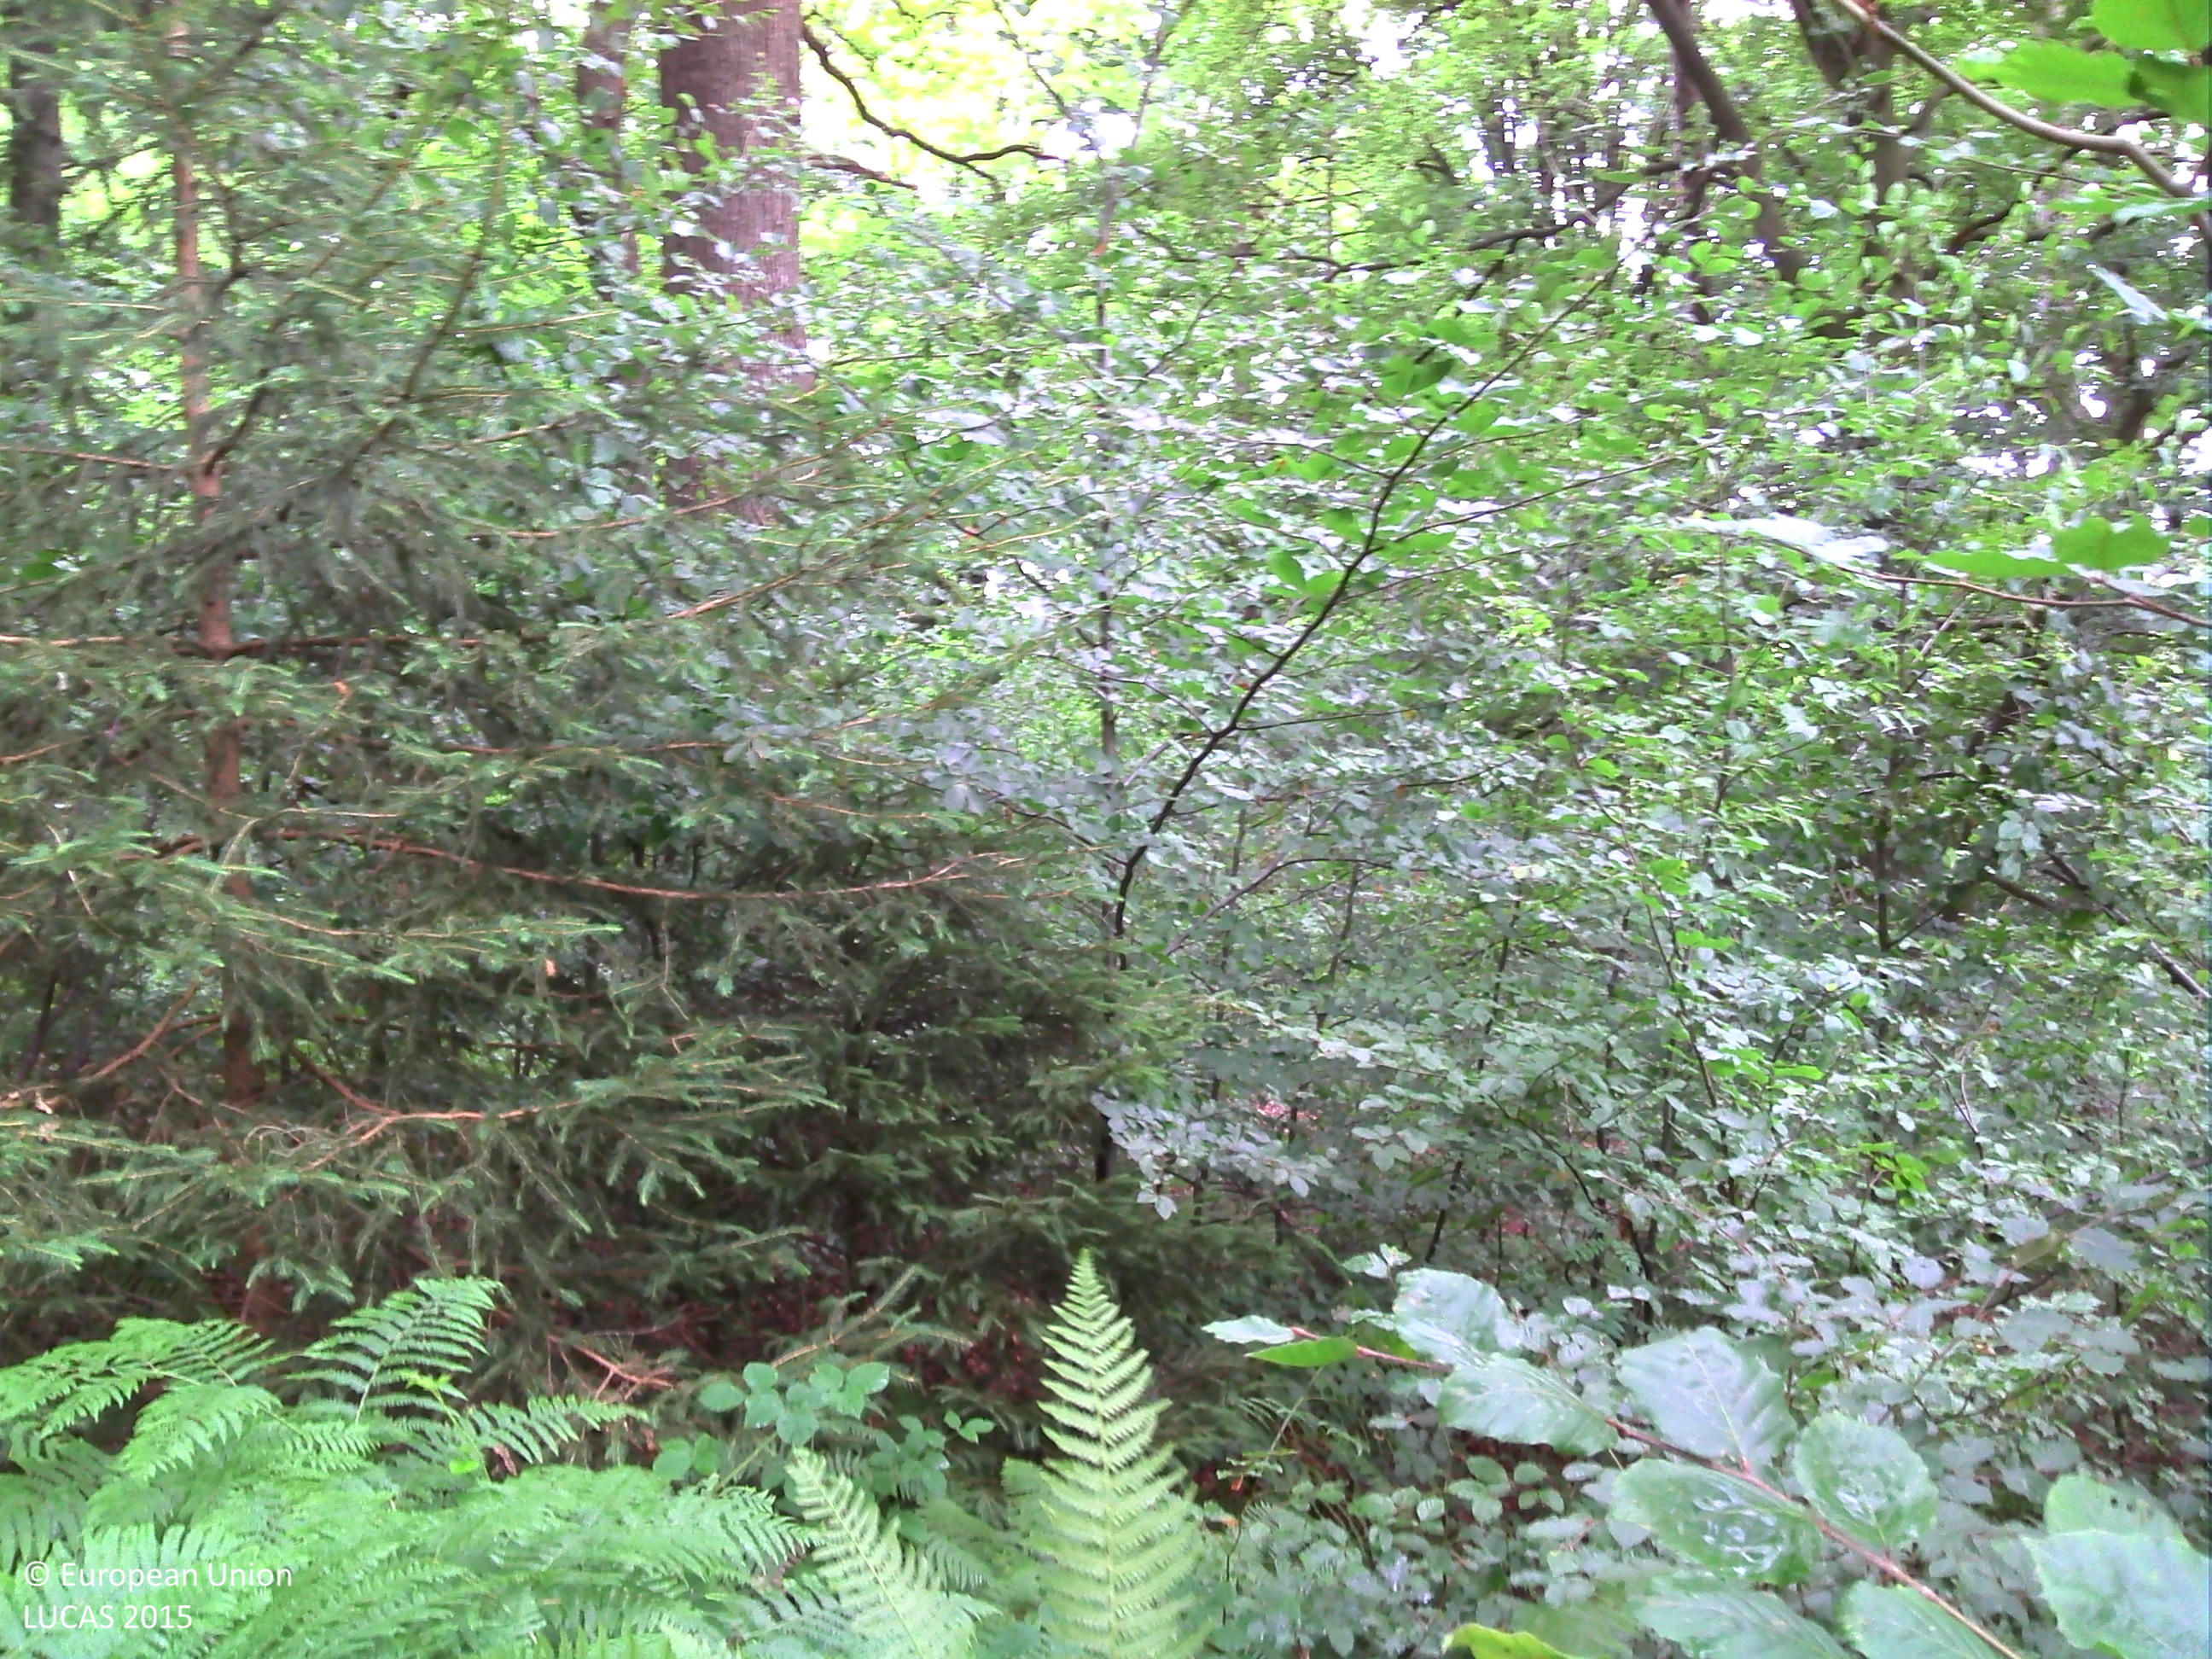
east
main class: Woodland
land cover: Broadleaved woodland
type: acidophilous oak and oak-birch forest
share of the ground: > 75 %
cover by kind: broadleaved forest trees 80 %, herbaceous plants 20 %
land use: Forestry
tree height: > 5 m
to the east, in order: Broadleaved woodland; Tracks; Broadleaved woodland; Rivers and streams; Broadleaved woodland; Tracks; Broadleaved woodland; Pine dominated mixed woodland
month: July
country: BE
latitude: 50.5265
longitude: 5.4700
